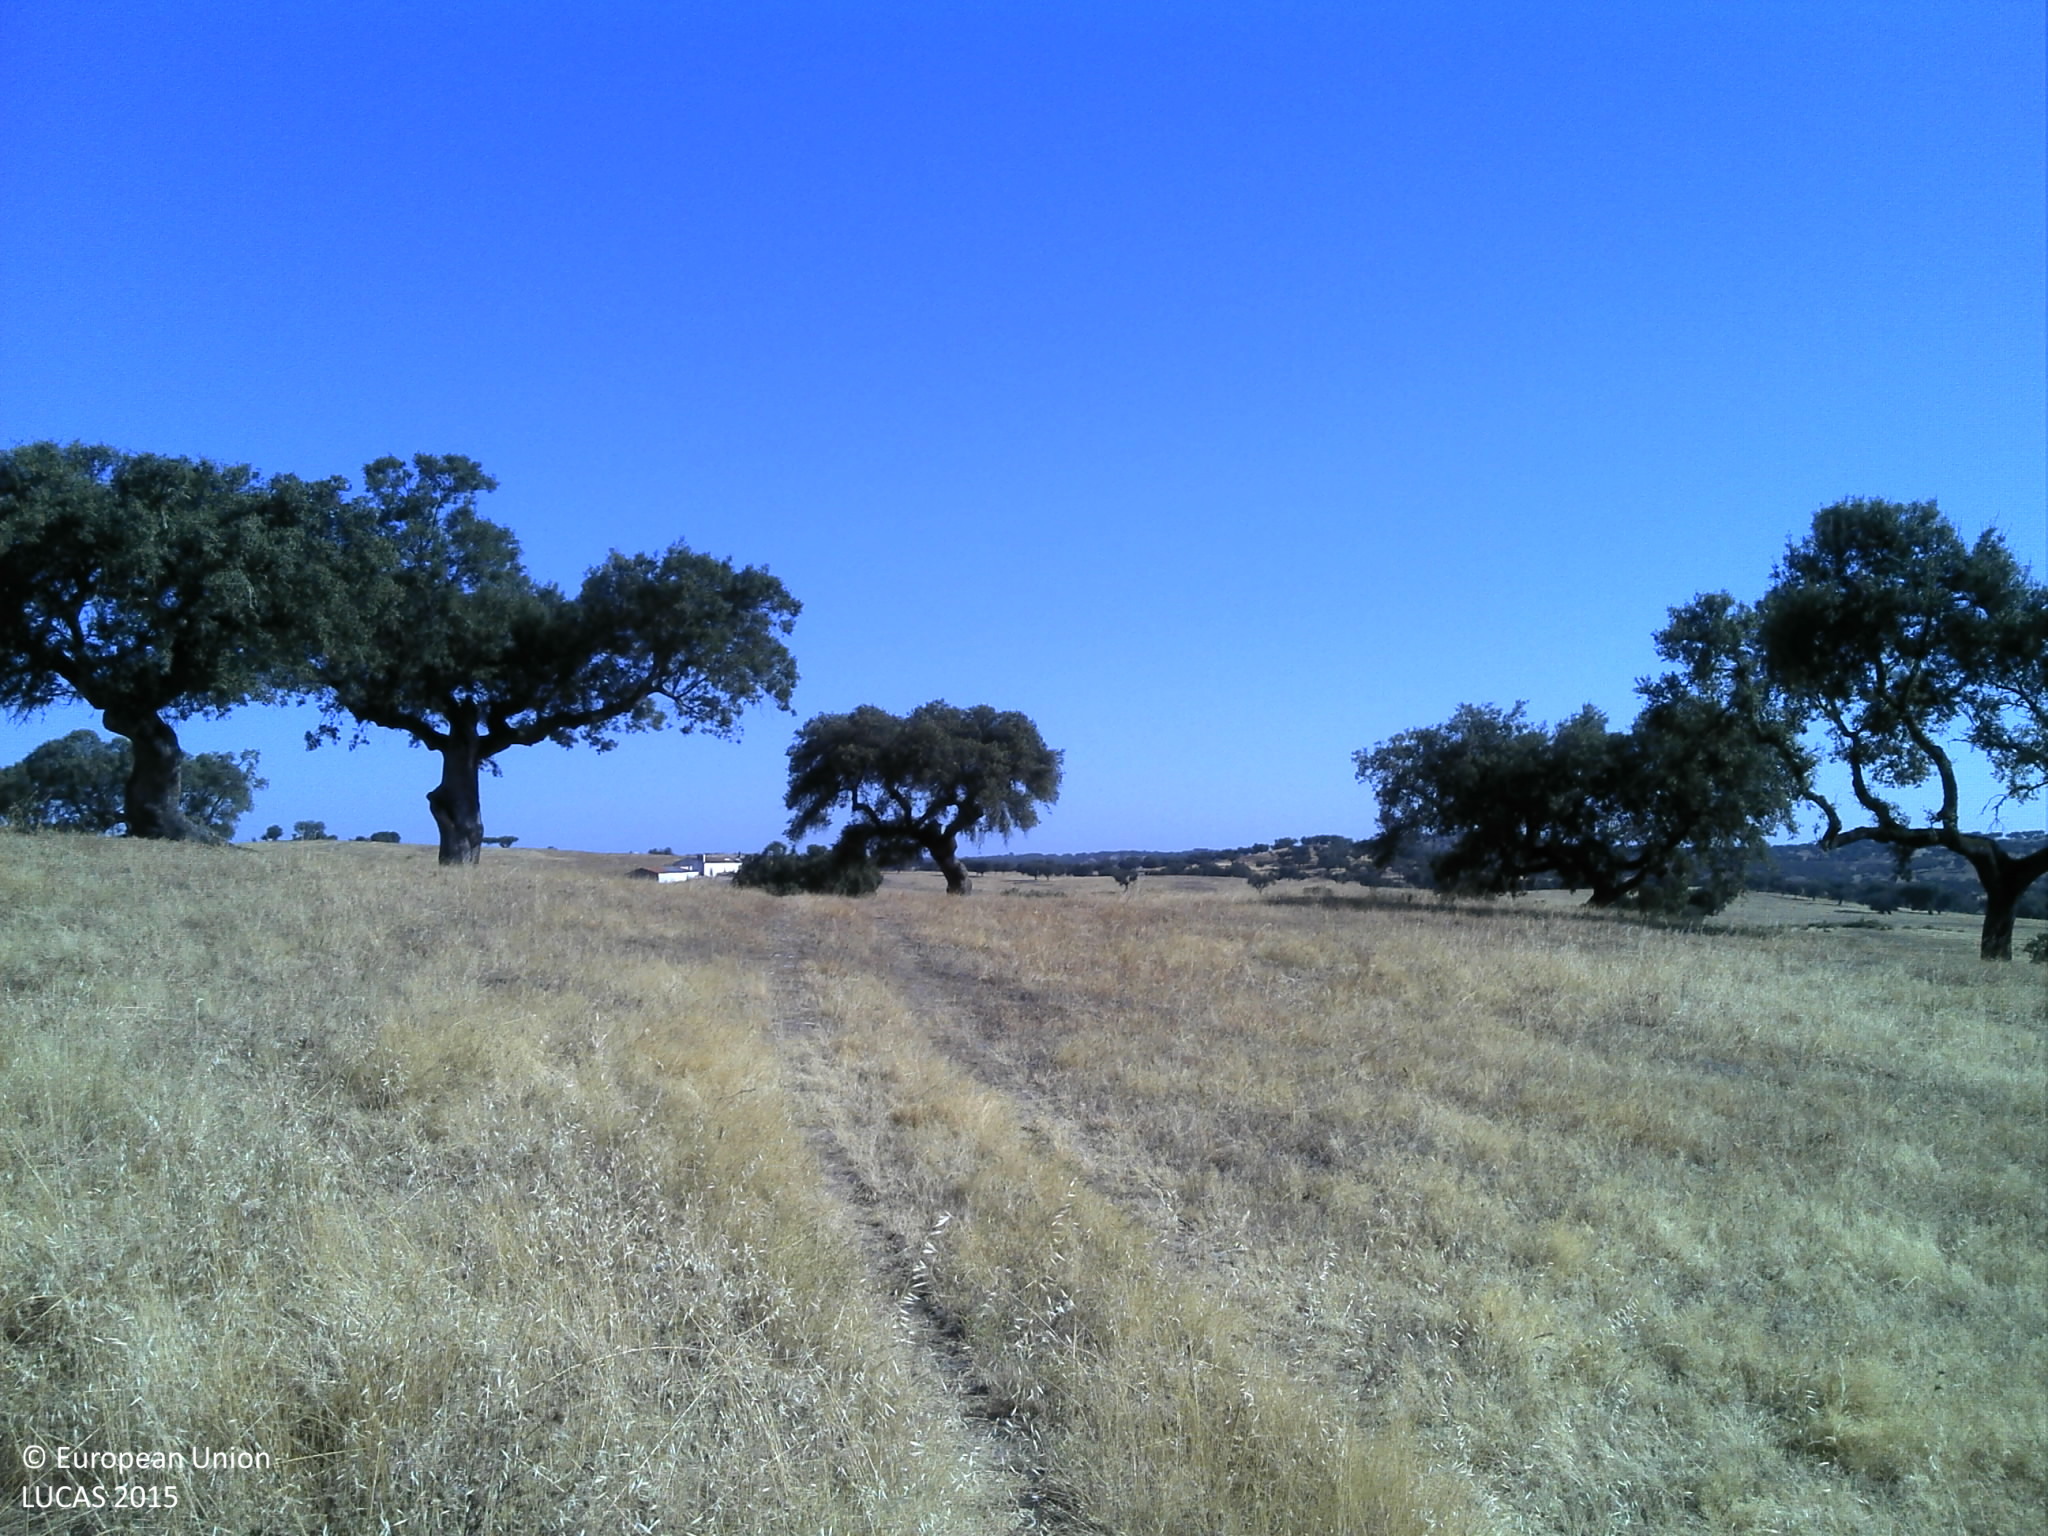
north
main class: Grassland
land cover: Grassland without tree/shrub cover
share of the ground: 50 - 75 %
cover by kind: herbaceous plants 75 %, unconsolidated bare surface 25 %
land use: Agriculture (excluding fallow land and kitchen gardens)
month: July
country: PT
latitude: 38.6443
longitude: -7.2951
